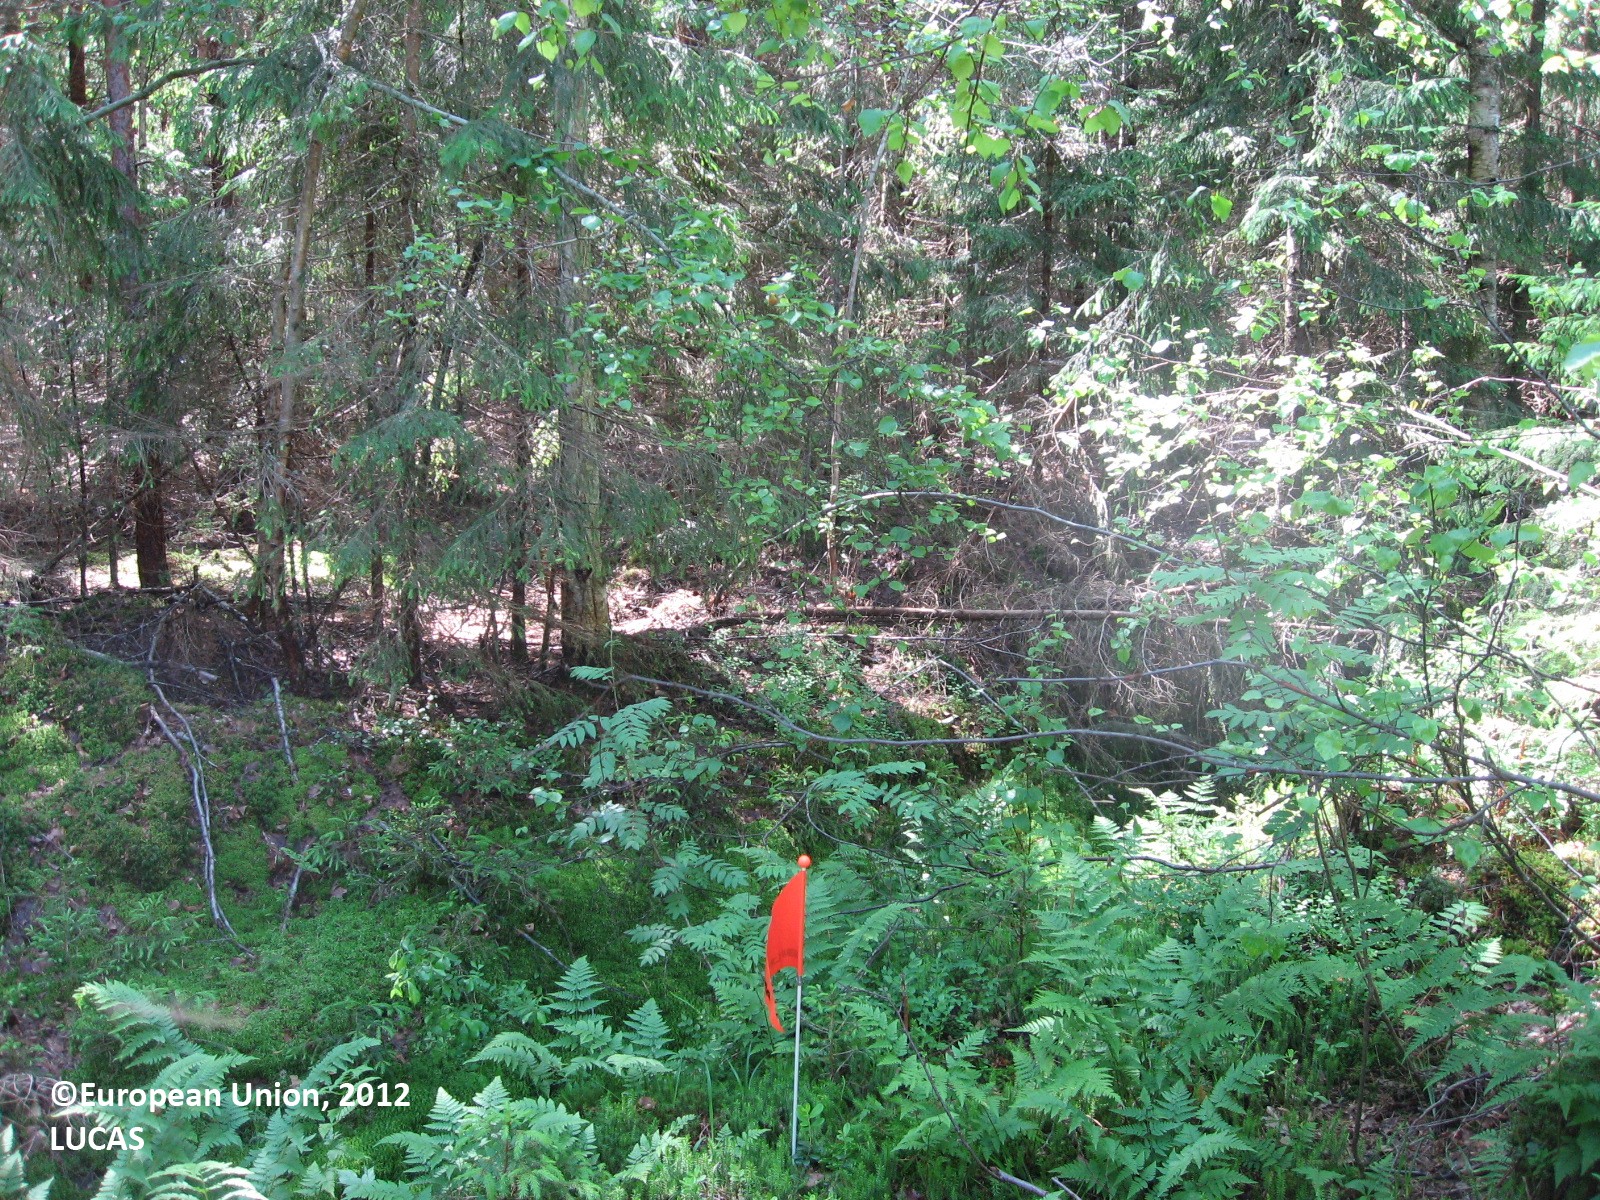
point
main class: Woodland
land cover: Other coniferous woodland
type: boreal forest
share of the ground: 50 - 75 %
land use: Forestry
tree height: > 5 m
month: June
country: FI
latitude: 60.5266
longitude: 26.3495
